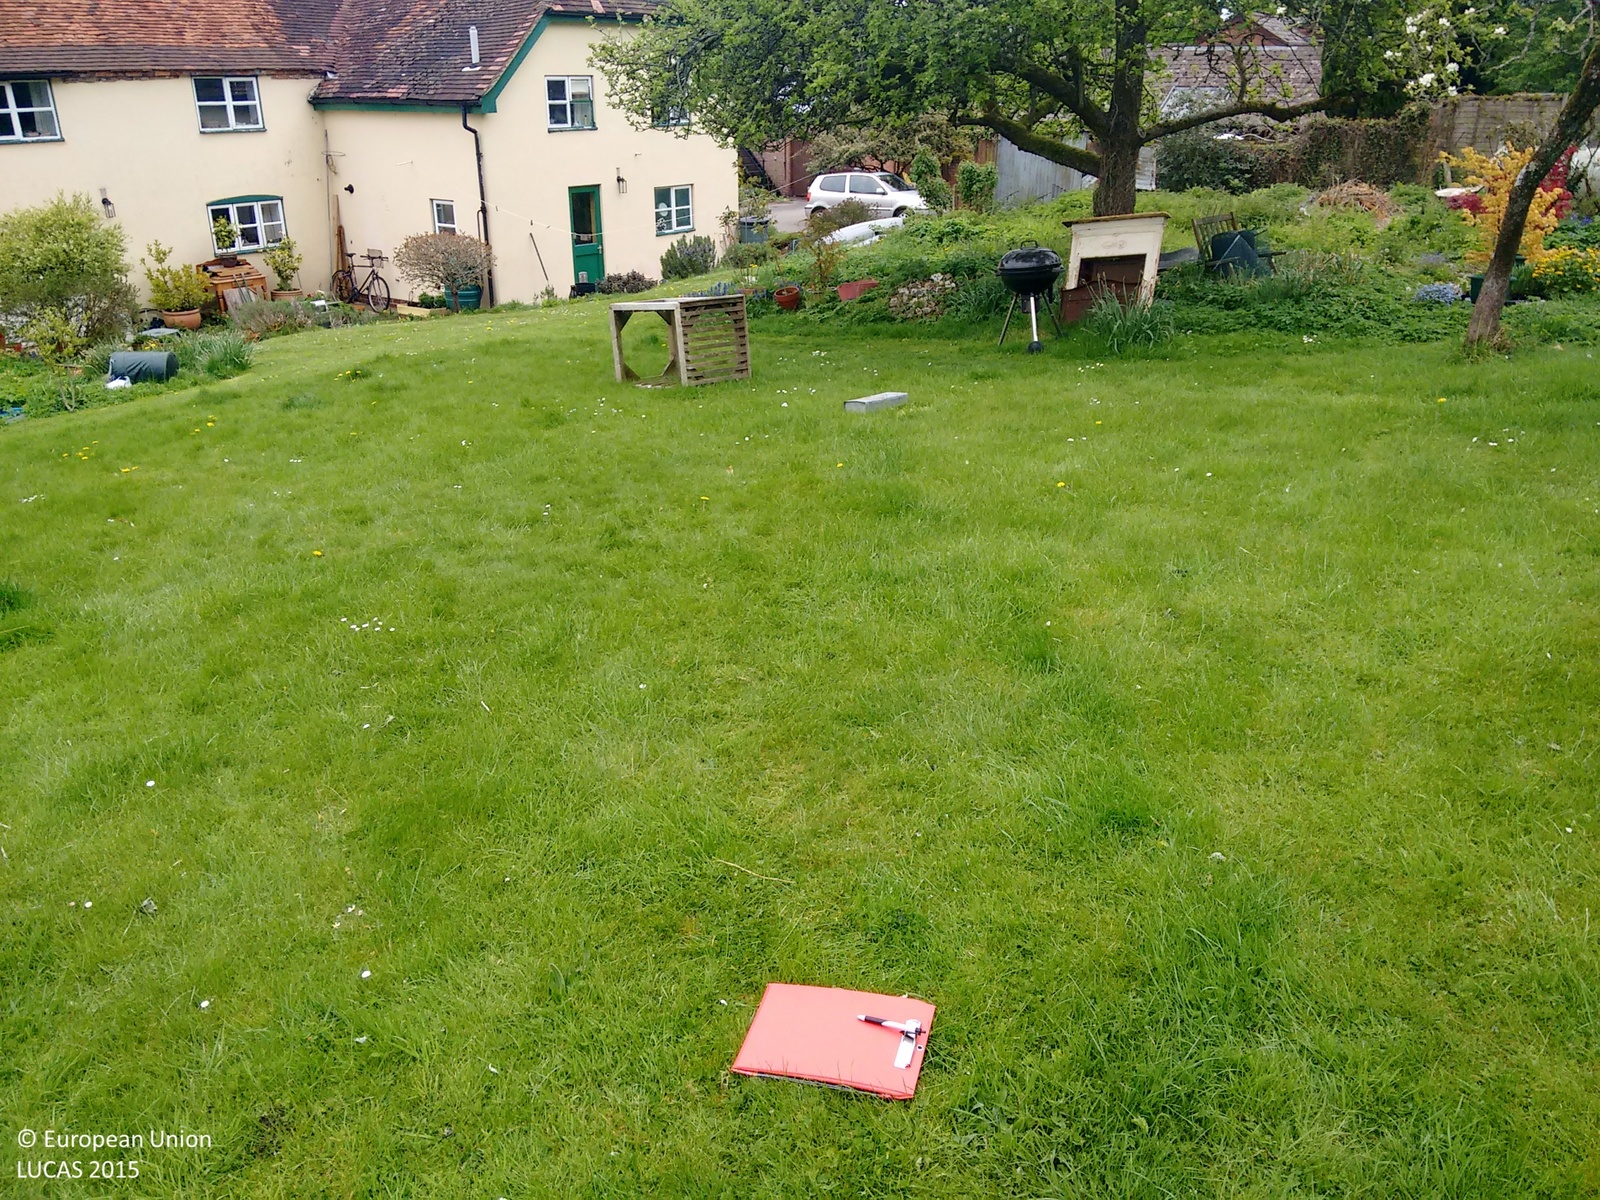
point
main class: Grassland
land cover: Grassland with sparse tree/shrub cover
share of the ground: > 75 %
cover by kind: herbaceous plants 85 %, shrubs 10 %, broadleaved forest trees 5 %
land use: Residential
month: May
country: GB
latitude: 51.3065
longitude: -1.5127
